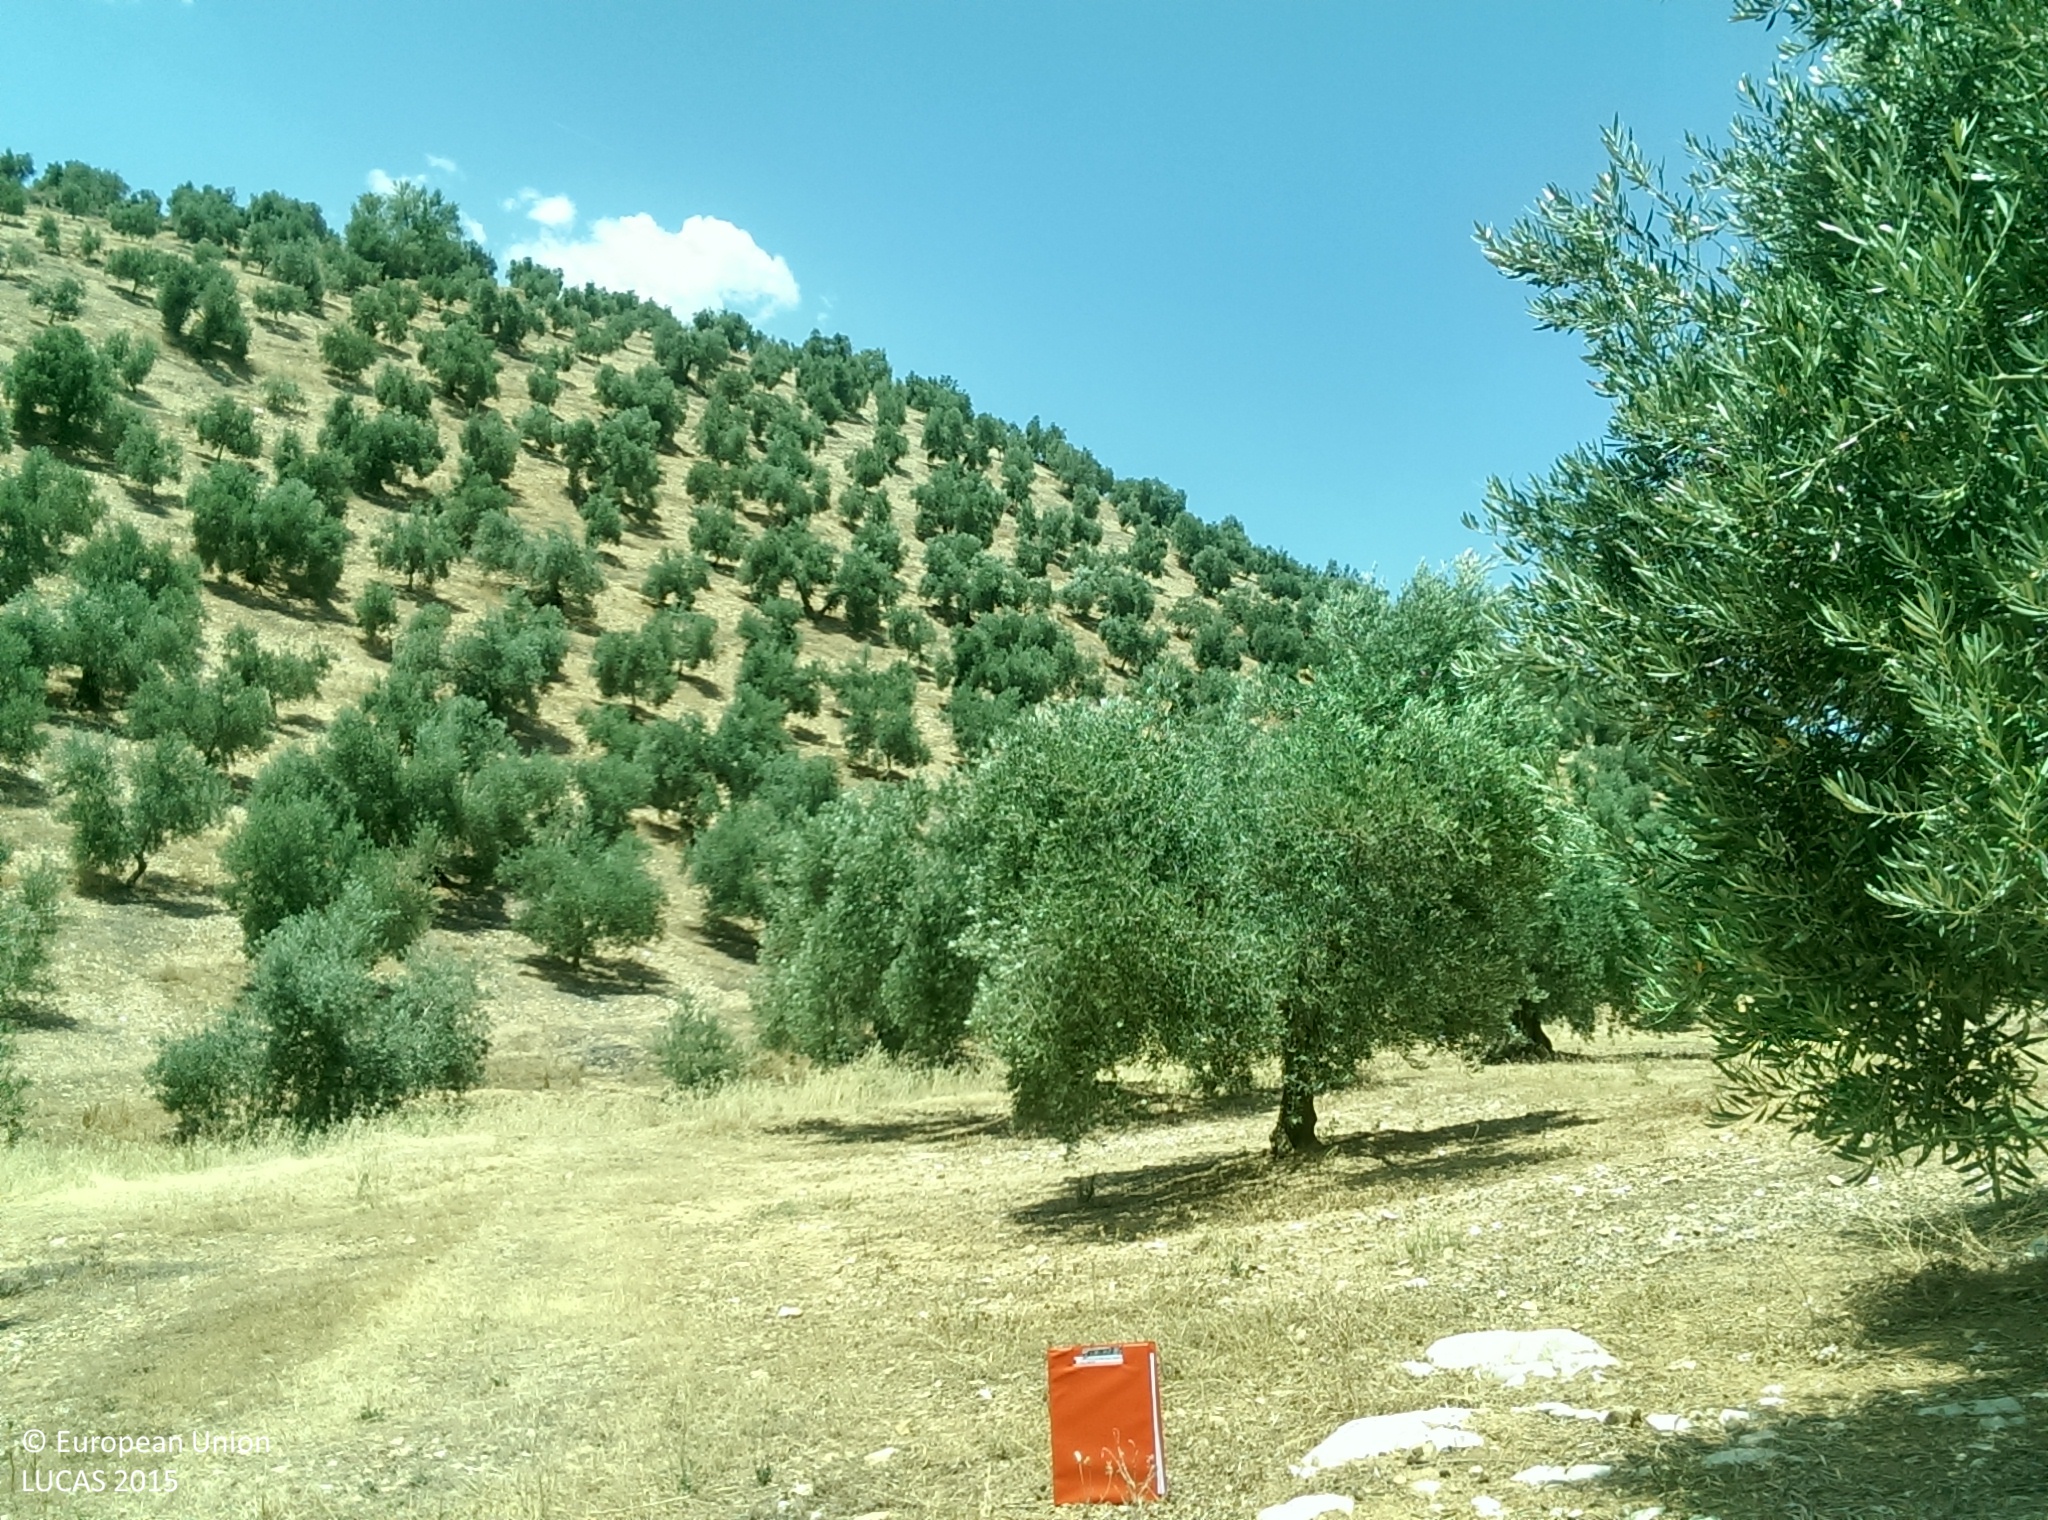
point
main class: Cropland
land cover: Olive groves
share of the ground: 50 - 75 %
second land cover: Spontaneously vegetated surfaces
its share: 10 - 25 %
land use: Agriculture (excluding fallow land and kitchen gardens)
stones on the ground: 10 - 25 %
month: July
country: ES
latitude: 37.4479
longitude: -3.7060
